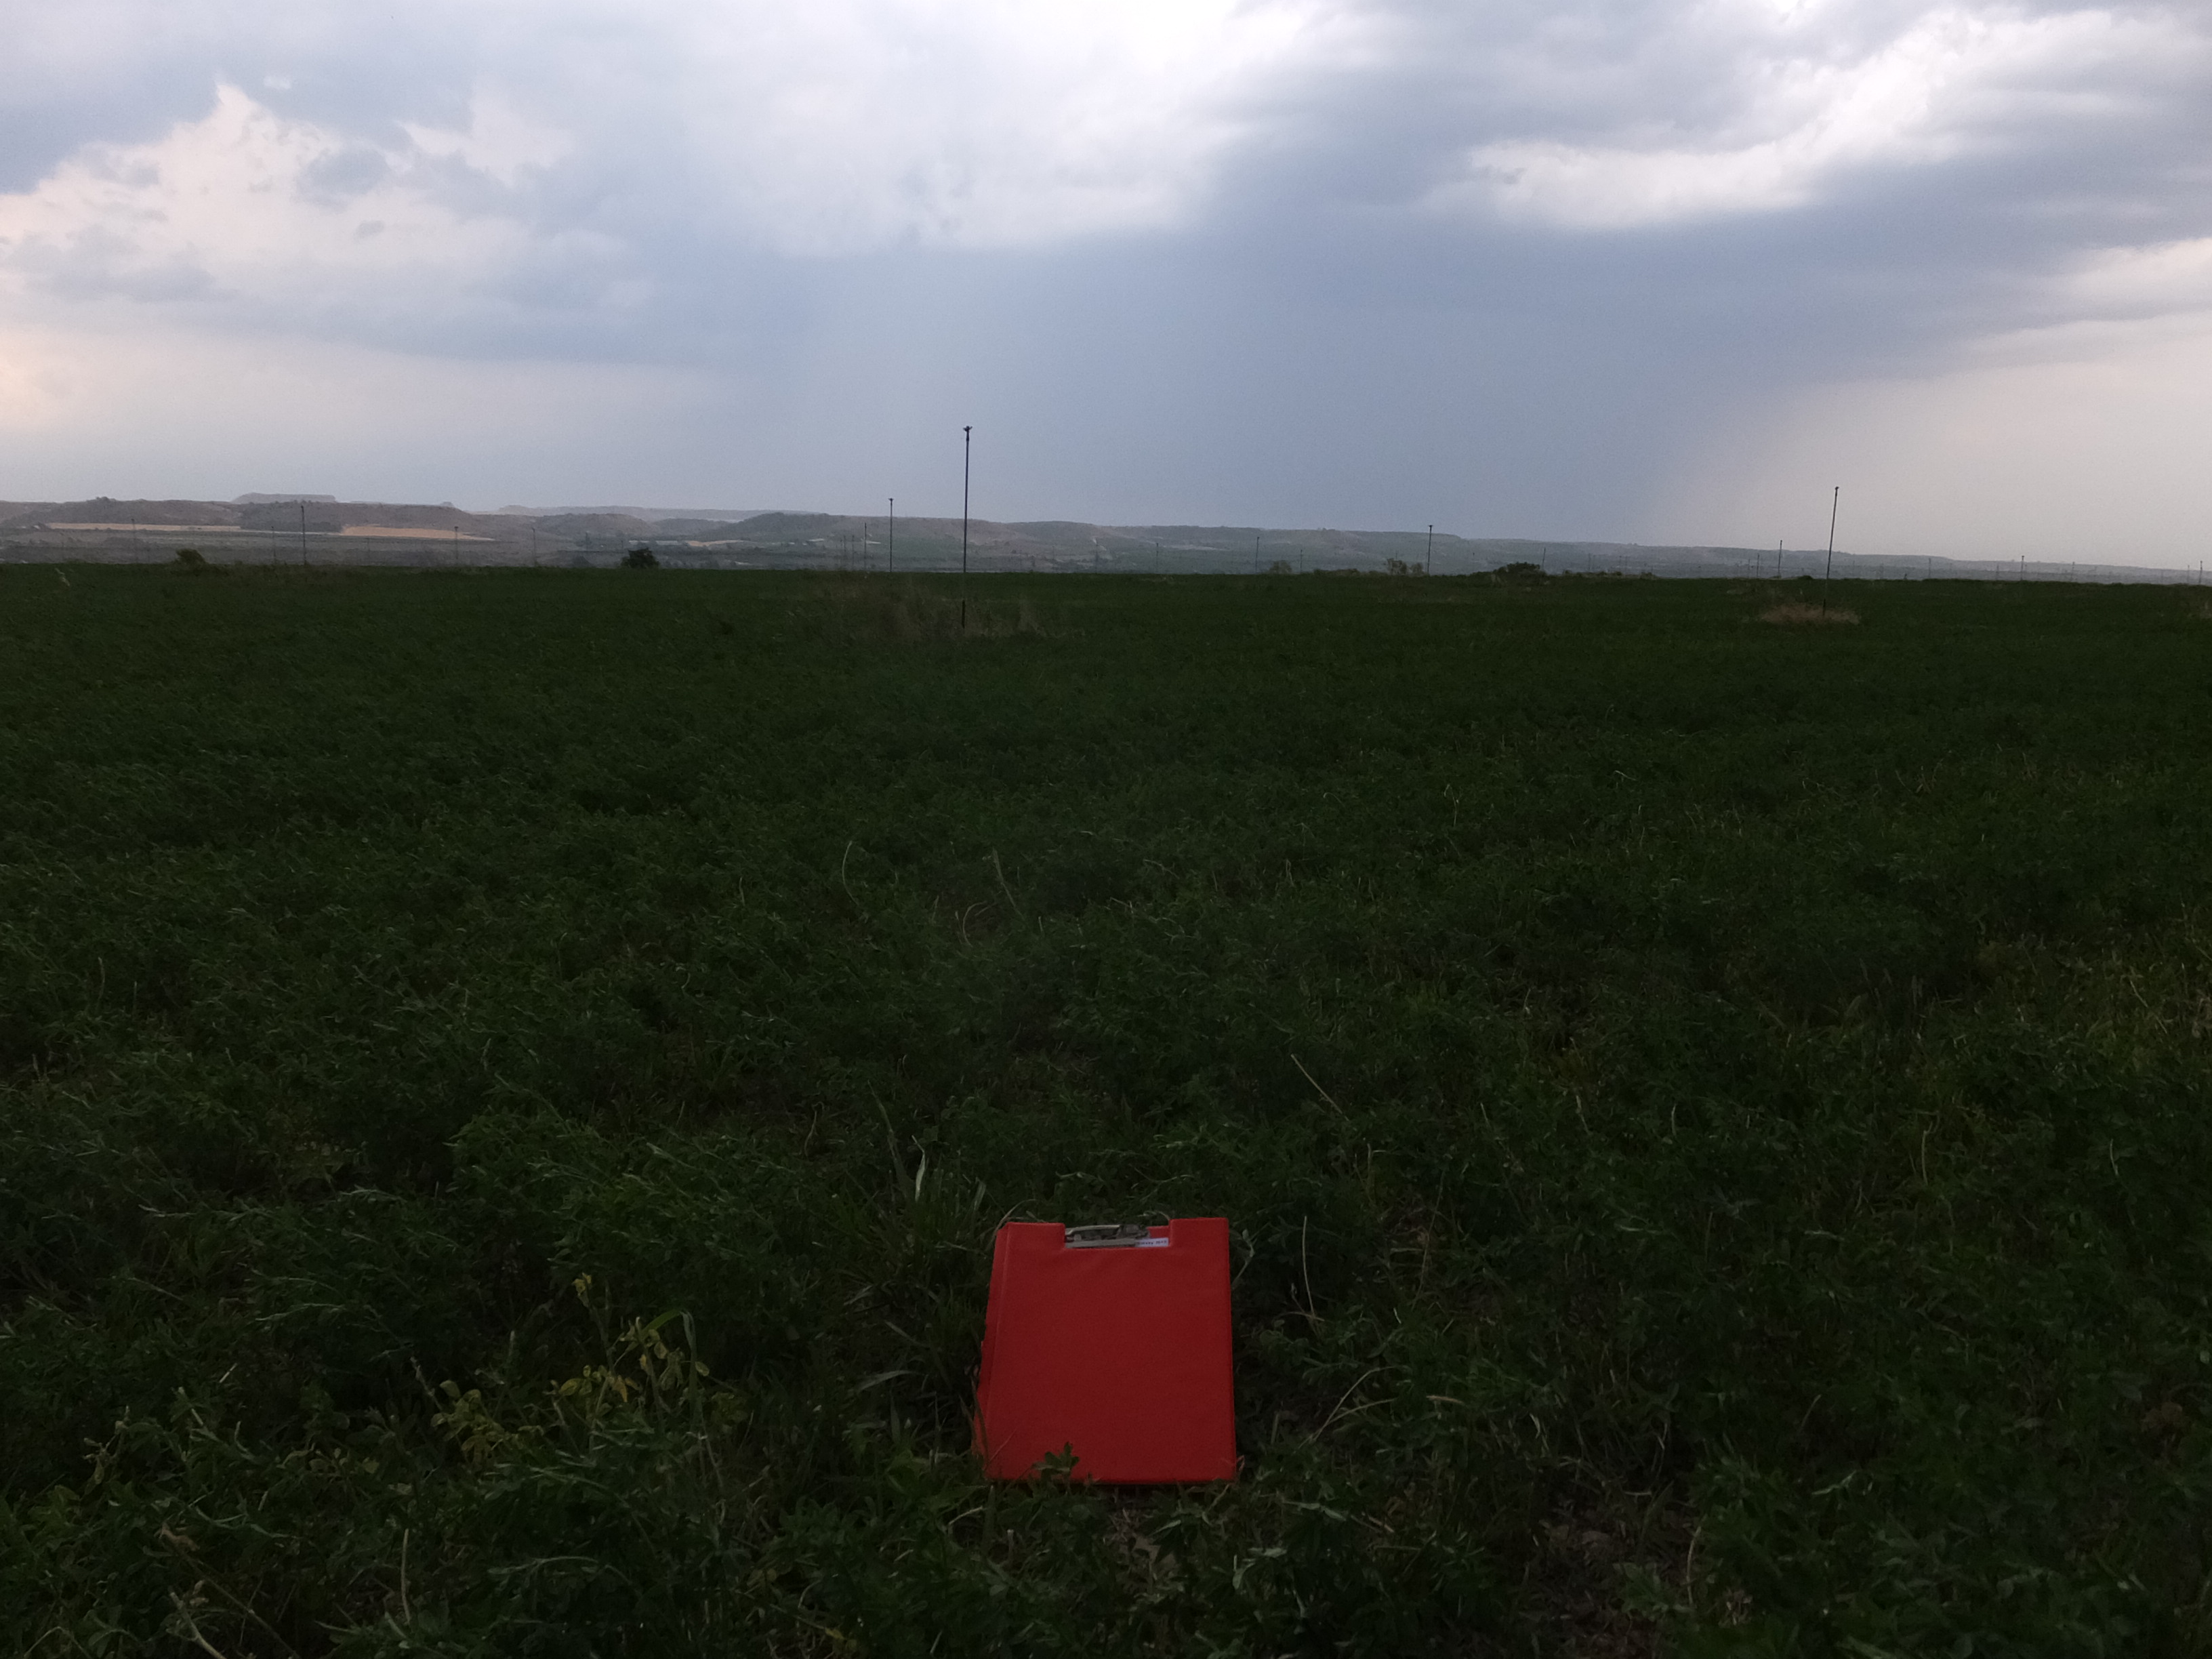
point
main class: Cropland
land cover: Lucerne
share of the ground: > 75 %
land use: Agriculture (excluding fallow land and kitchen gardens)
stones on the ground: < 10 %
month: June
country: ES
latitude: 41.8246
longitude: 0.1228
